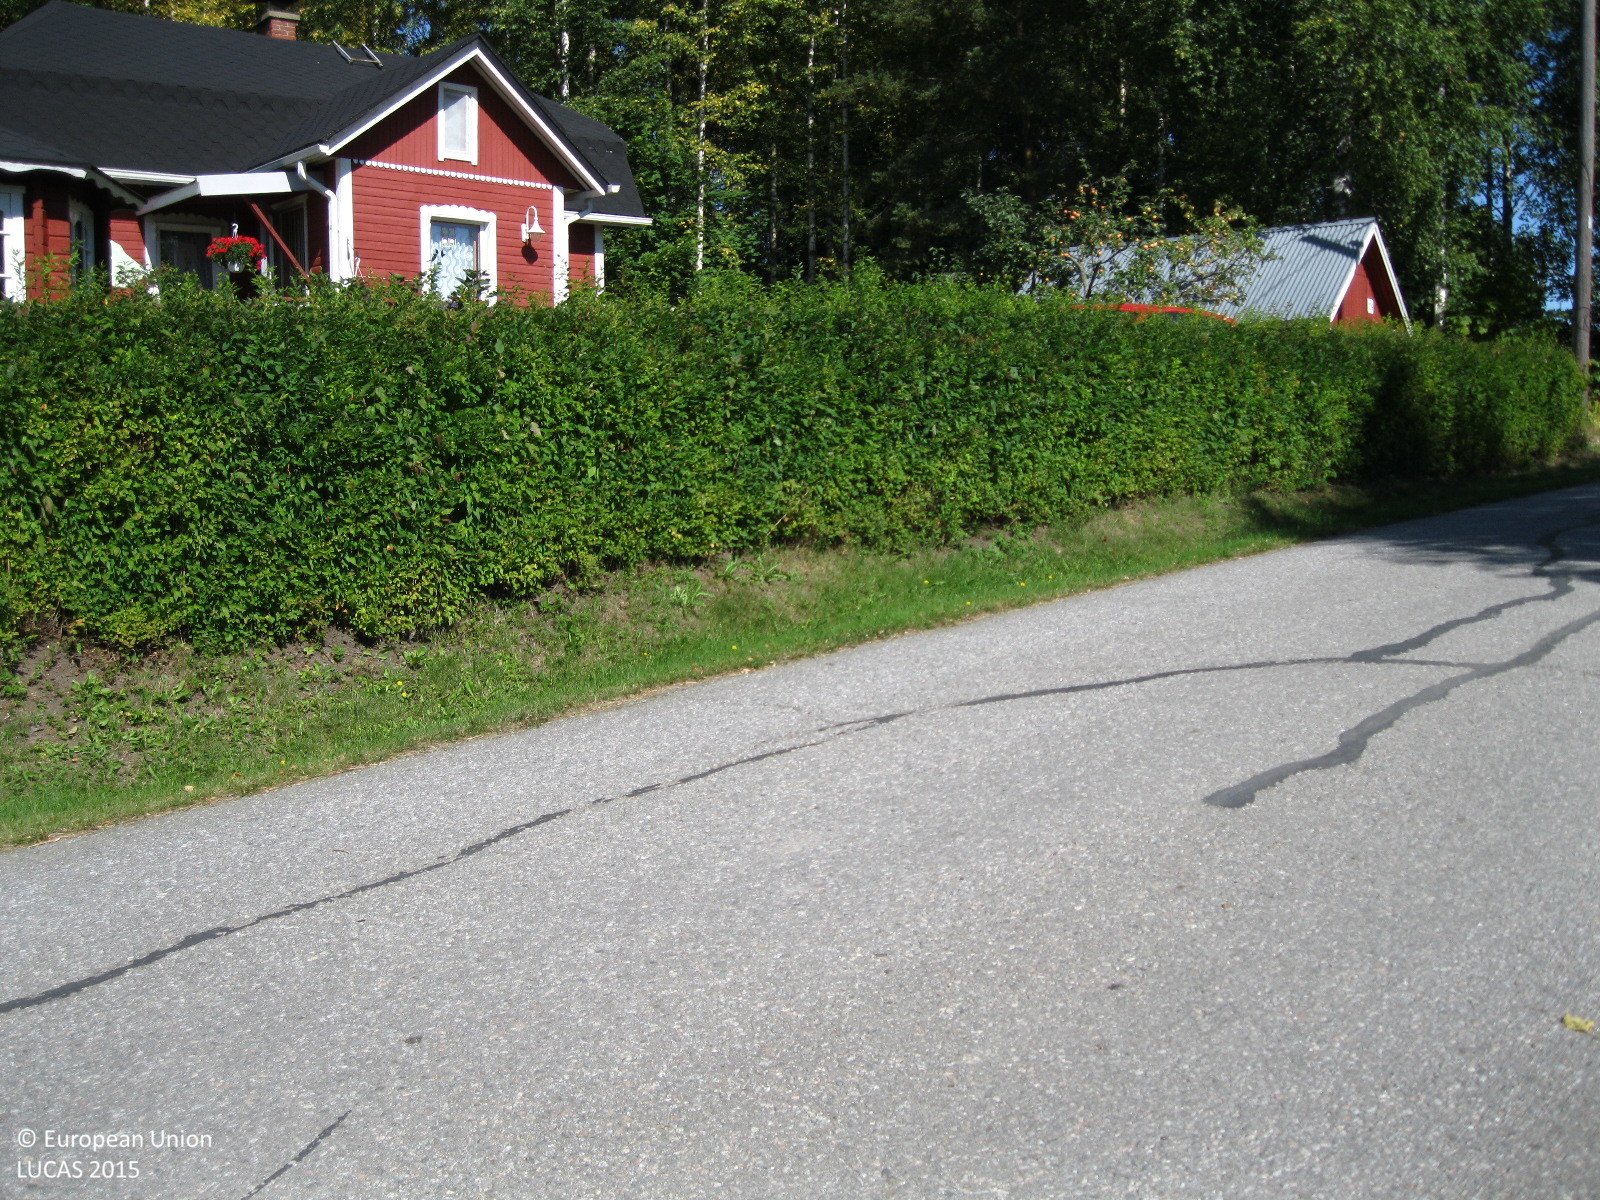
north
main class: Grassland
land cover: Spontaneously vegetated surfaces
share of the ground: > 75 %
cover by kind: herbaceous plants 100 %
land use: Road transport
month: August
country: FI
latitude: 61.2958
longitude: 25.0629
